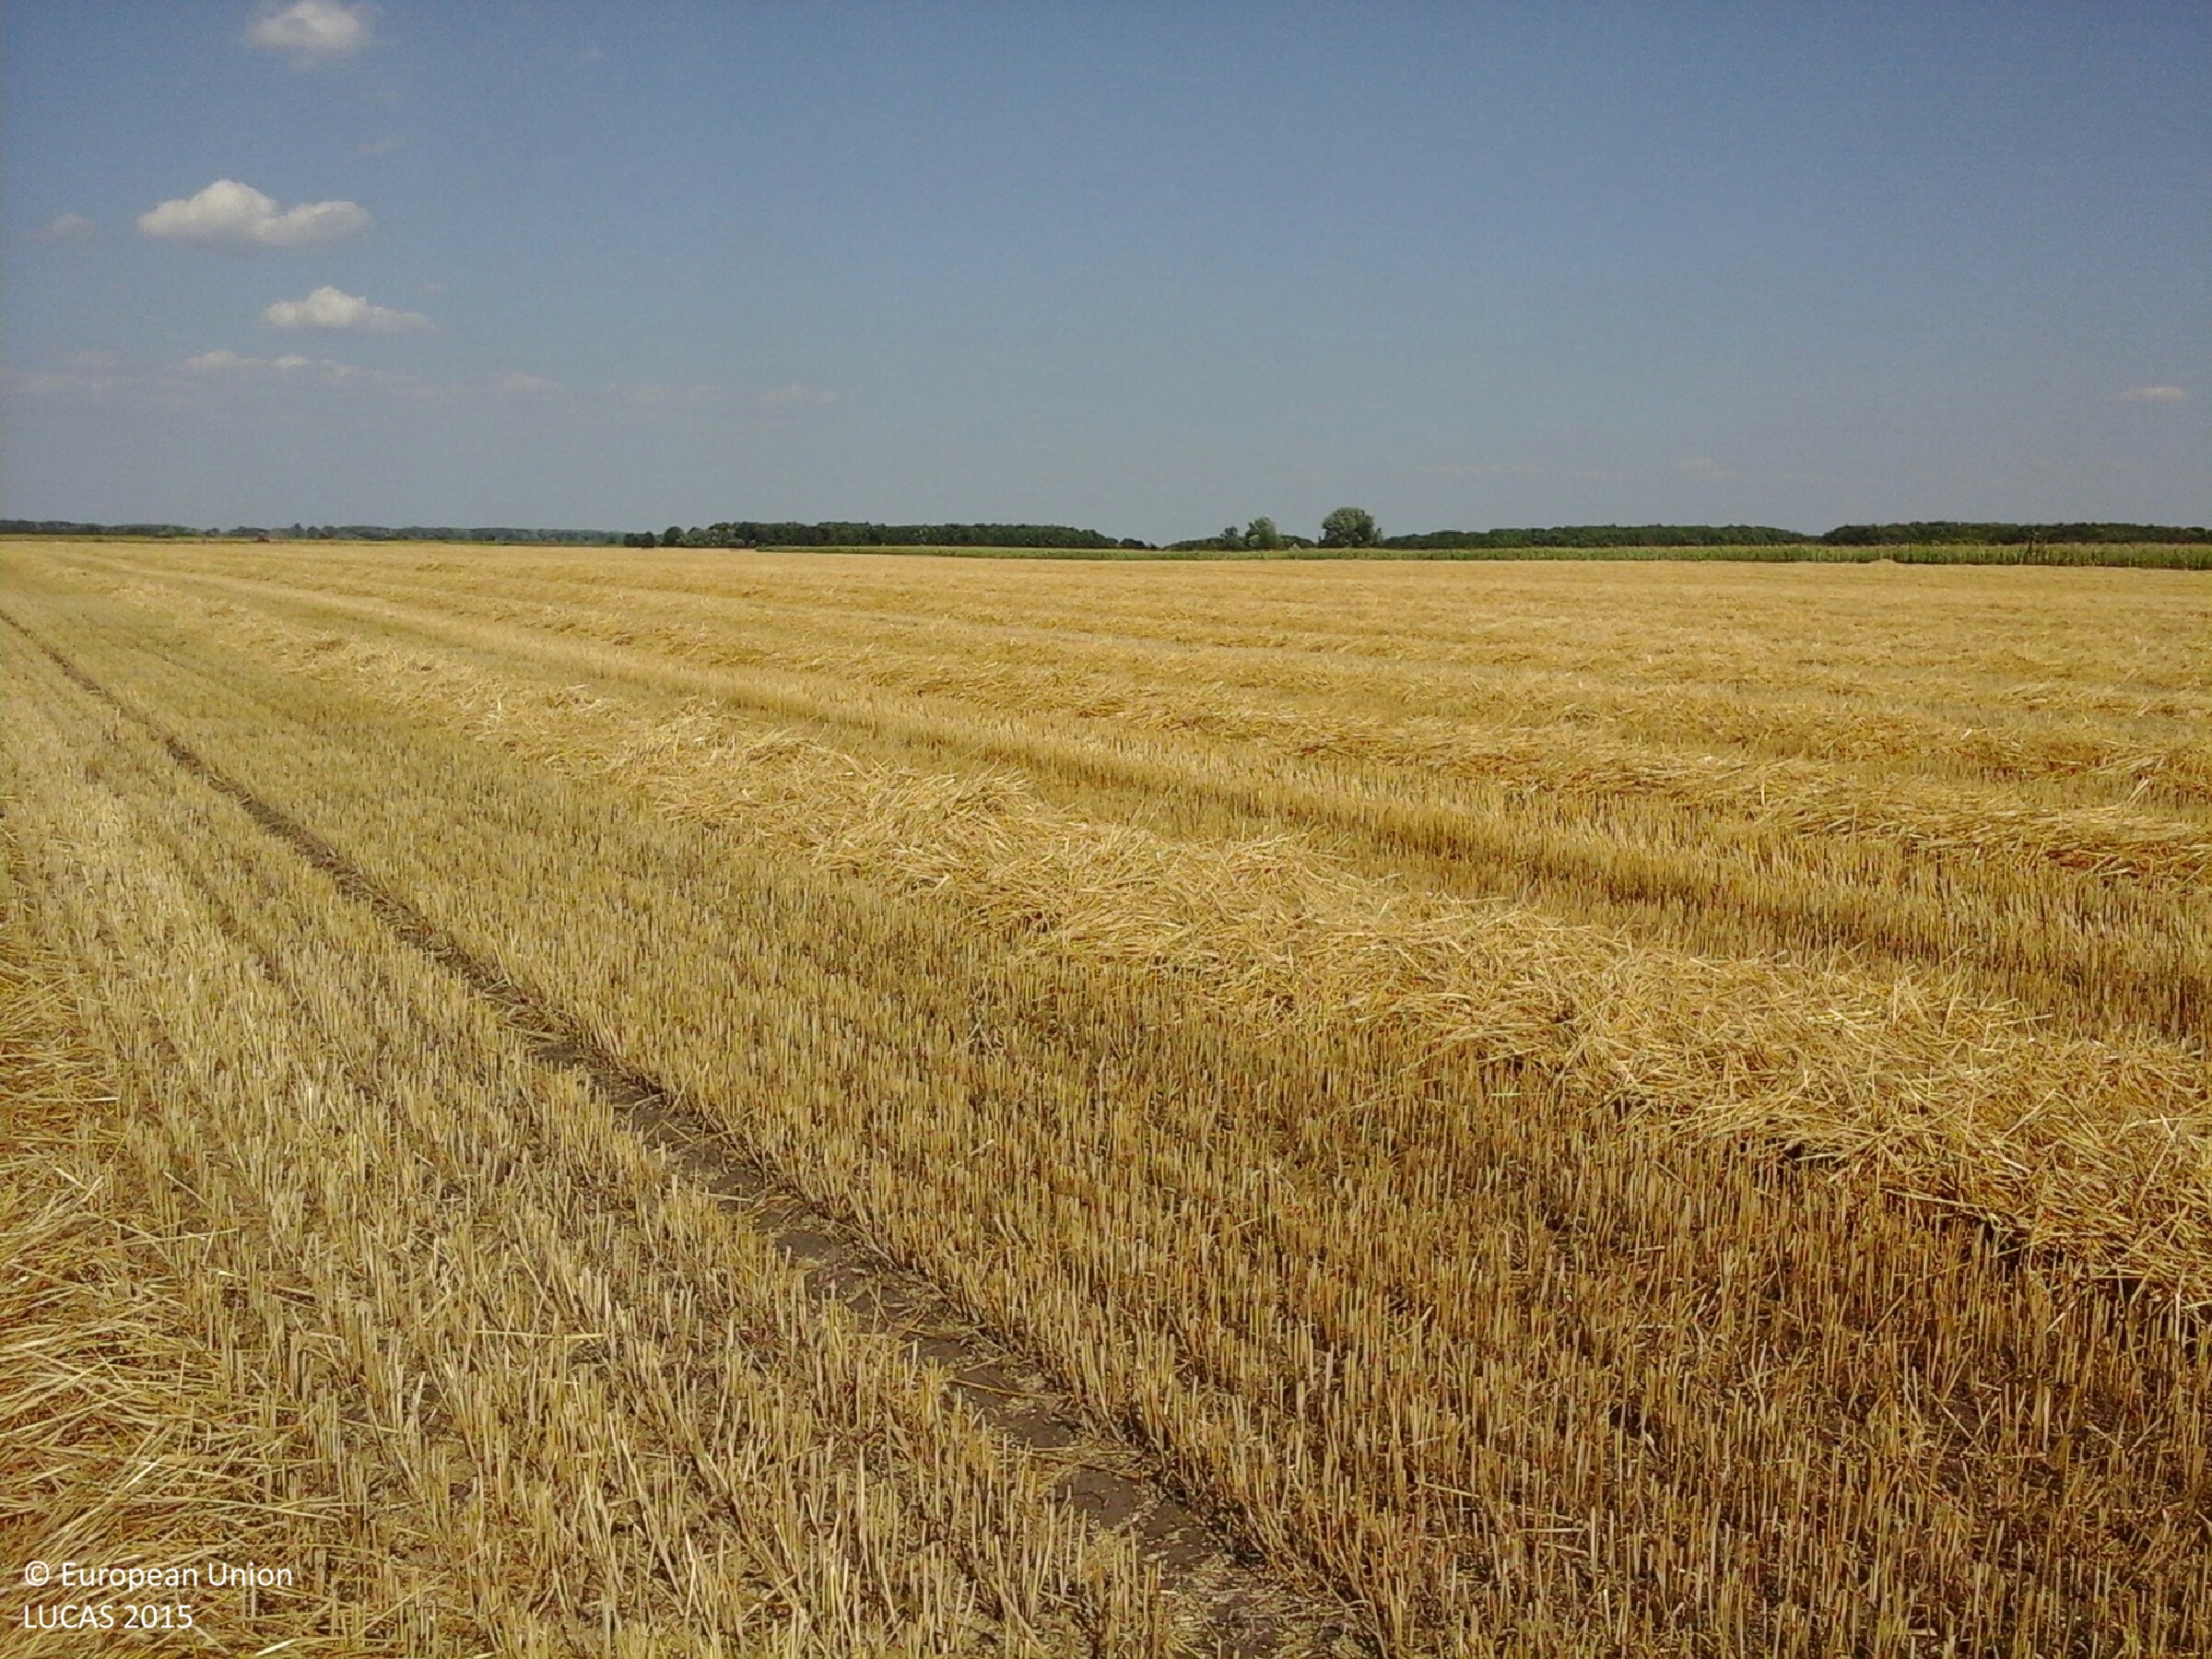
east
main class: Cropland
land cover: Common wheat
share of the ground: 50 - 75 %
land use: Agriculture (excluding fallow land and kitchen gardens)
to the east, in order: Common wheat
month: July
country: HU
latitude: 47.6498
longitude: 20.4822
